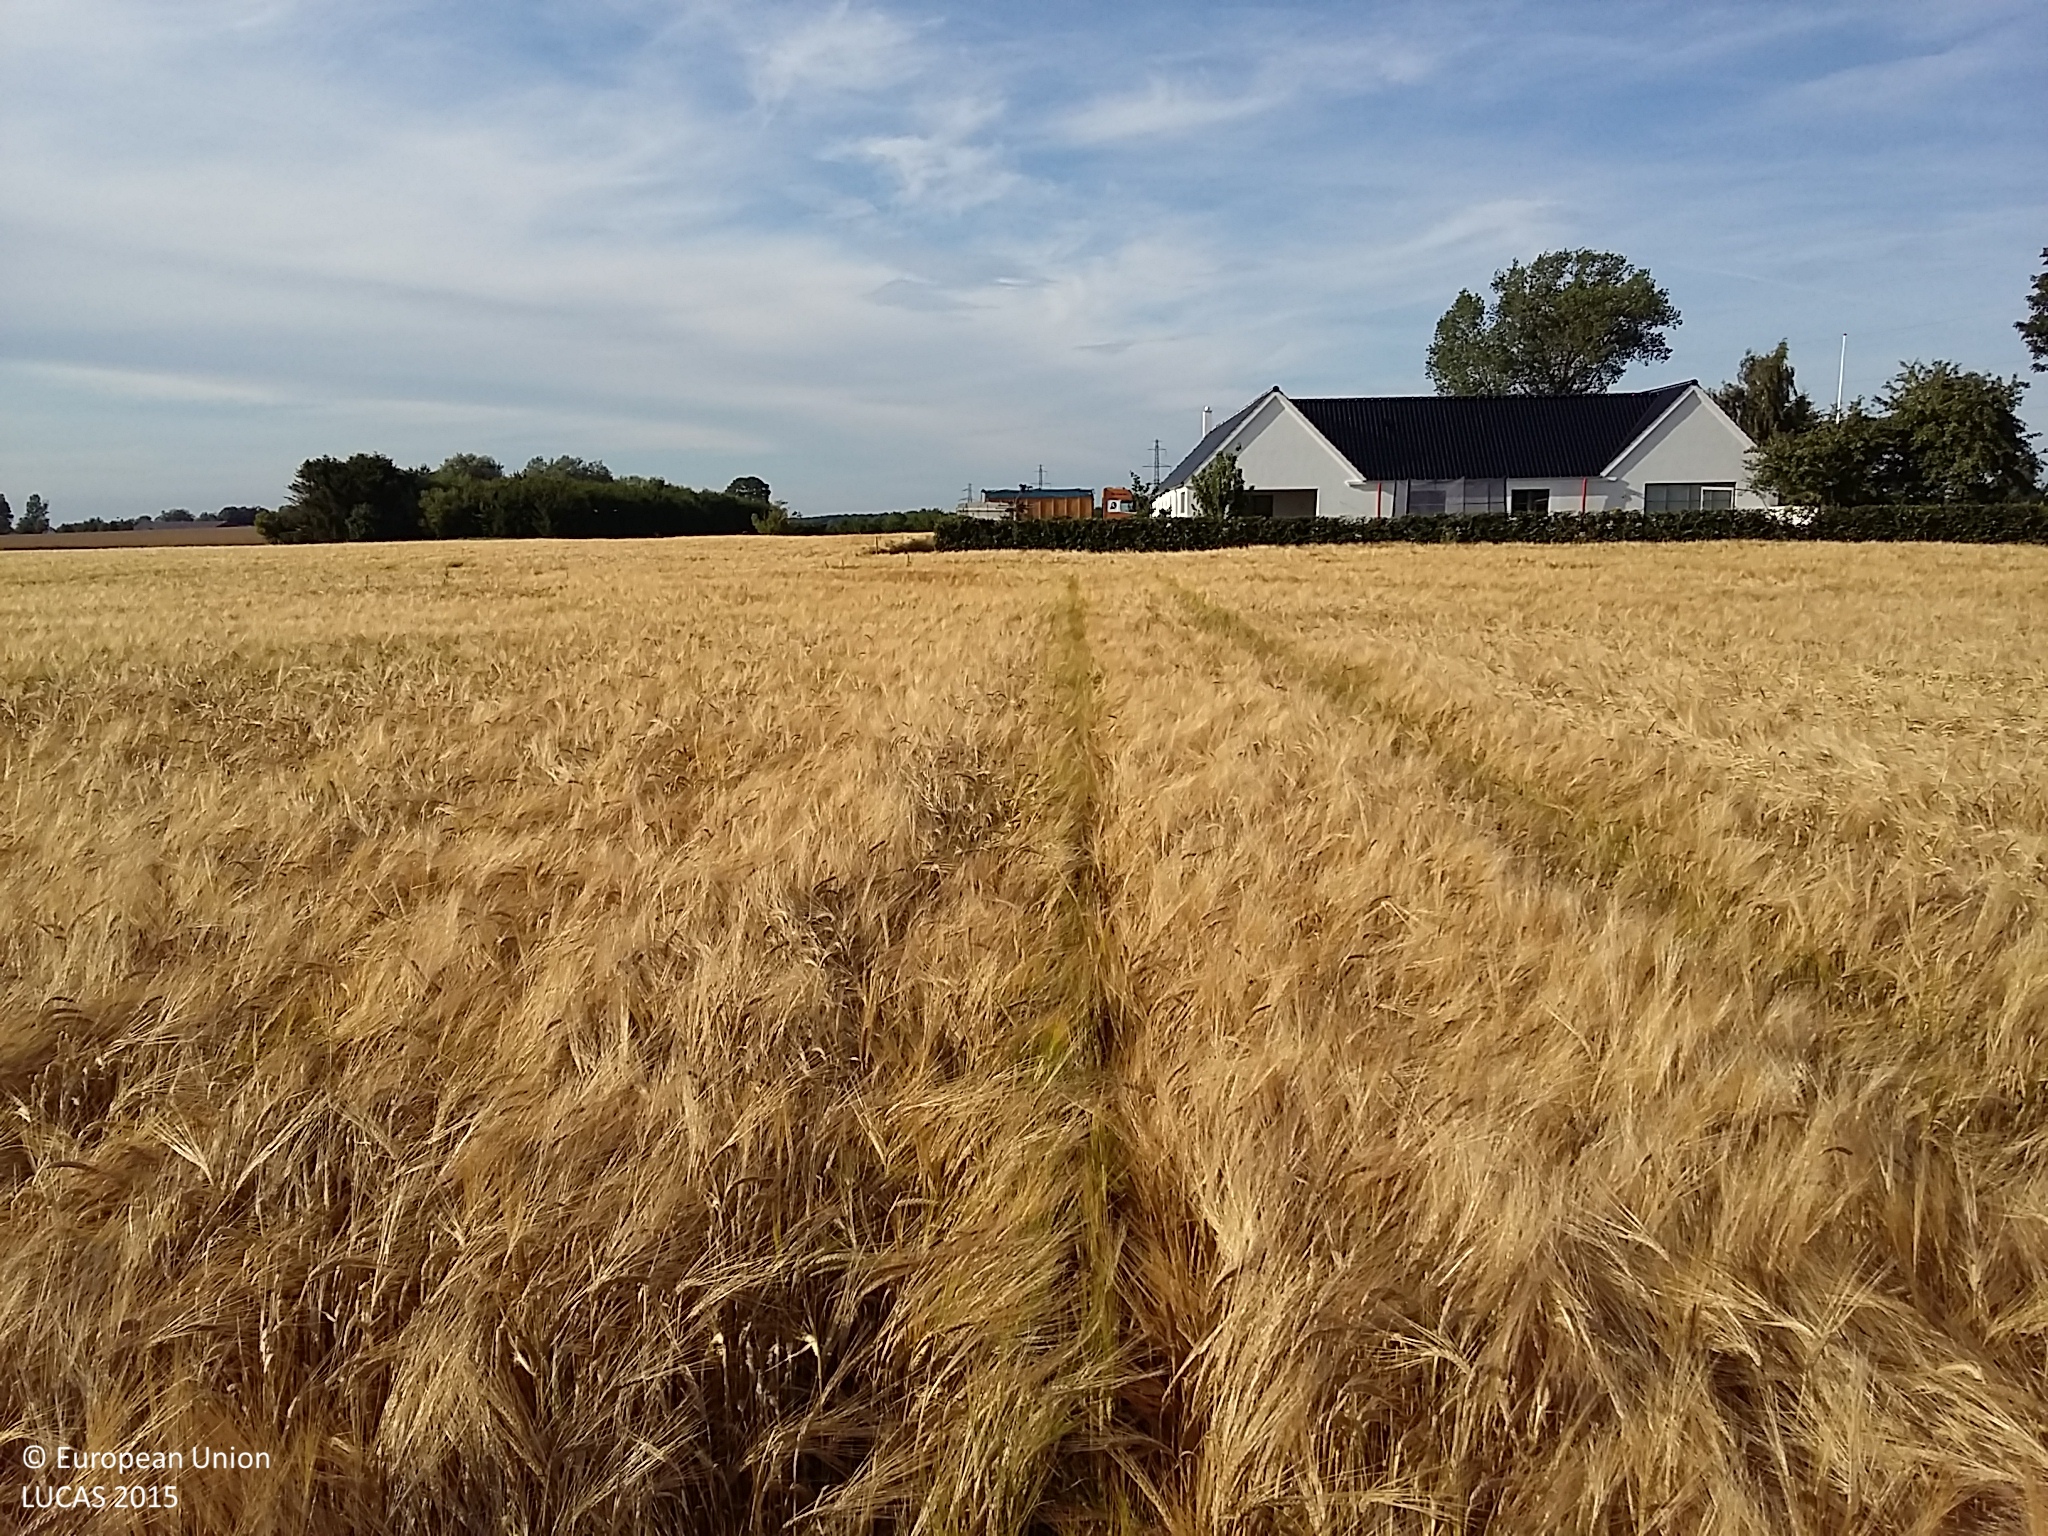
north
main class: Cropland
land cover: Barley
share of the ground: > 75 %
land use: Agriculture (excluding fallow land and kitchen gardens)
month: August
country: DK
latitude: 55.5242
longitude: 12.0417
